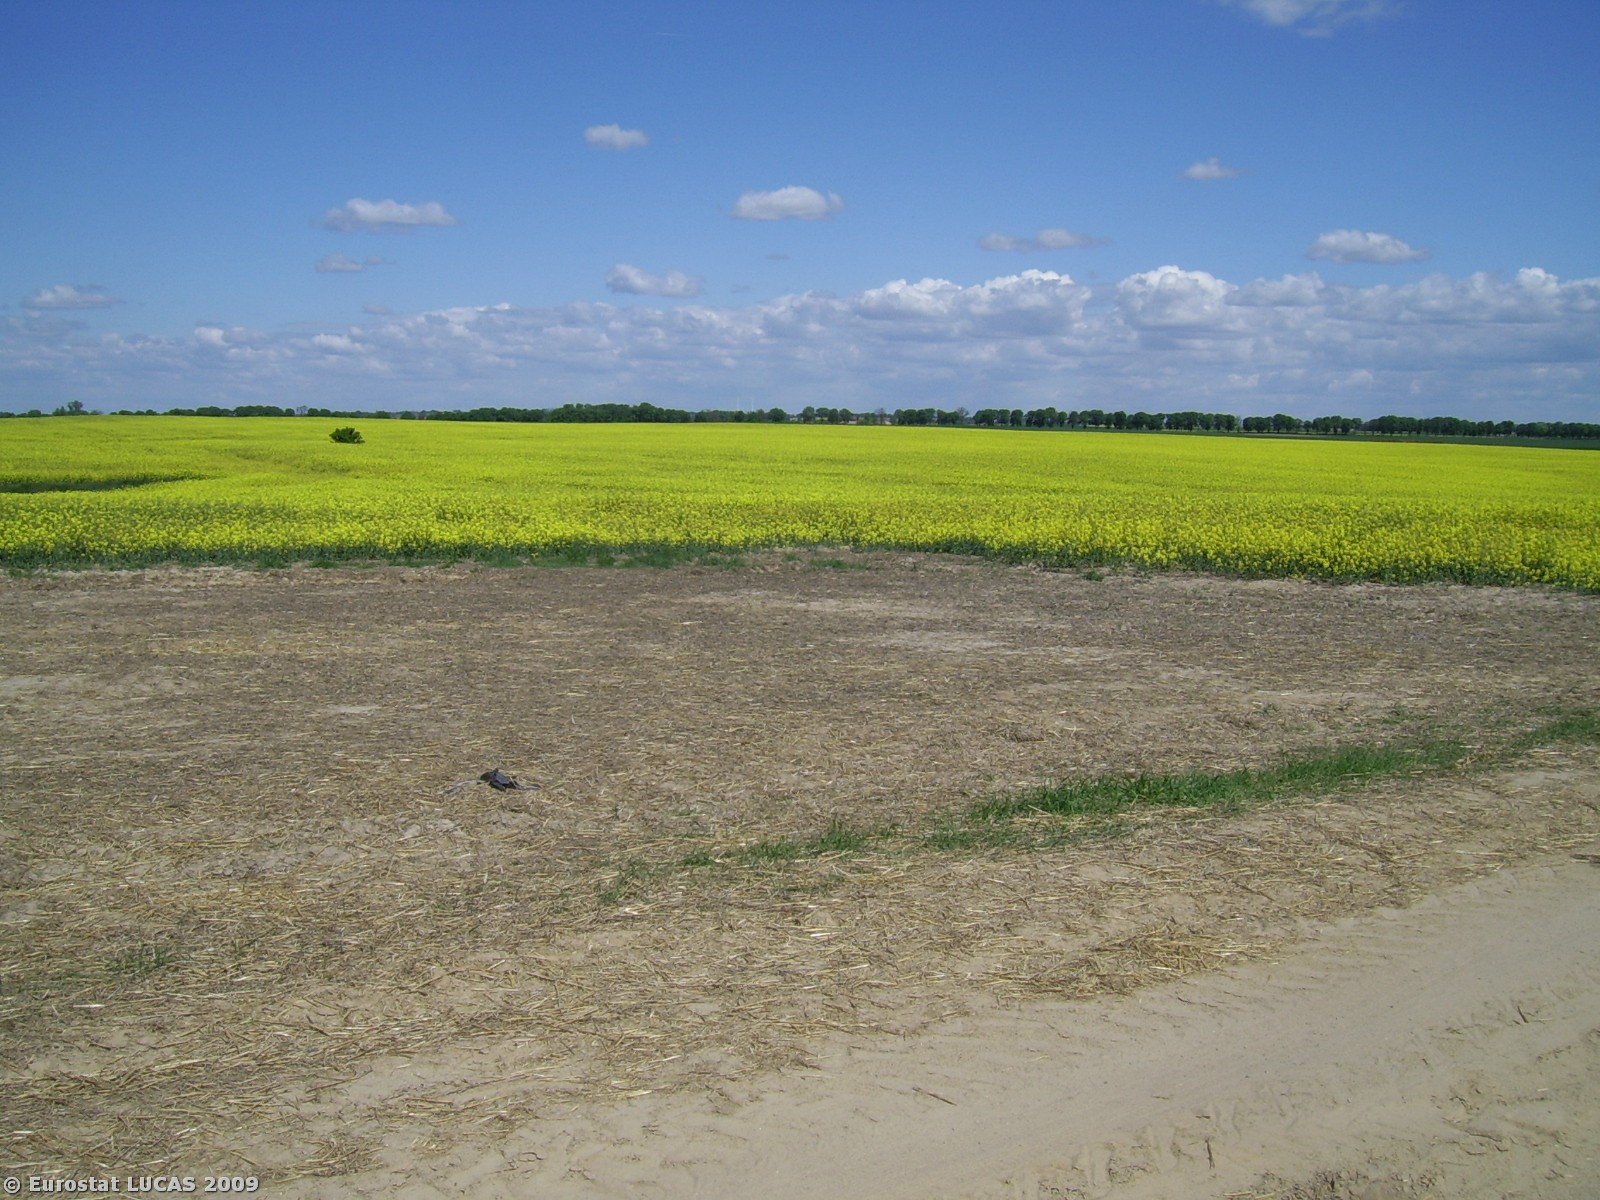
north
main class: Cropland
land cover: Common wheat
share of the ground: > 75 %
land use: Agriculture (excluding fallow land and kitchen gardens)
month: May
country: PL
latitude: 52.5313
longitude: 17.8718
